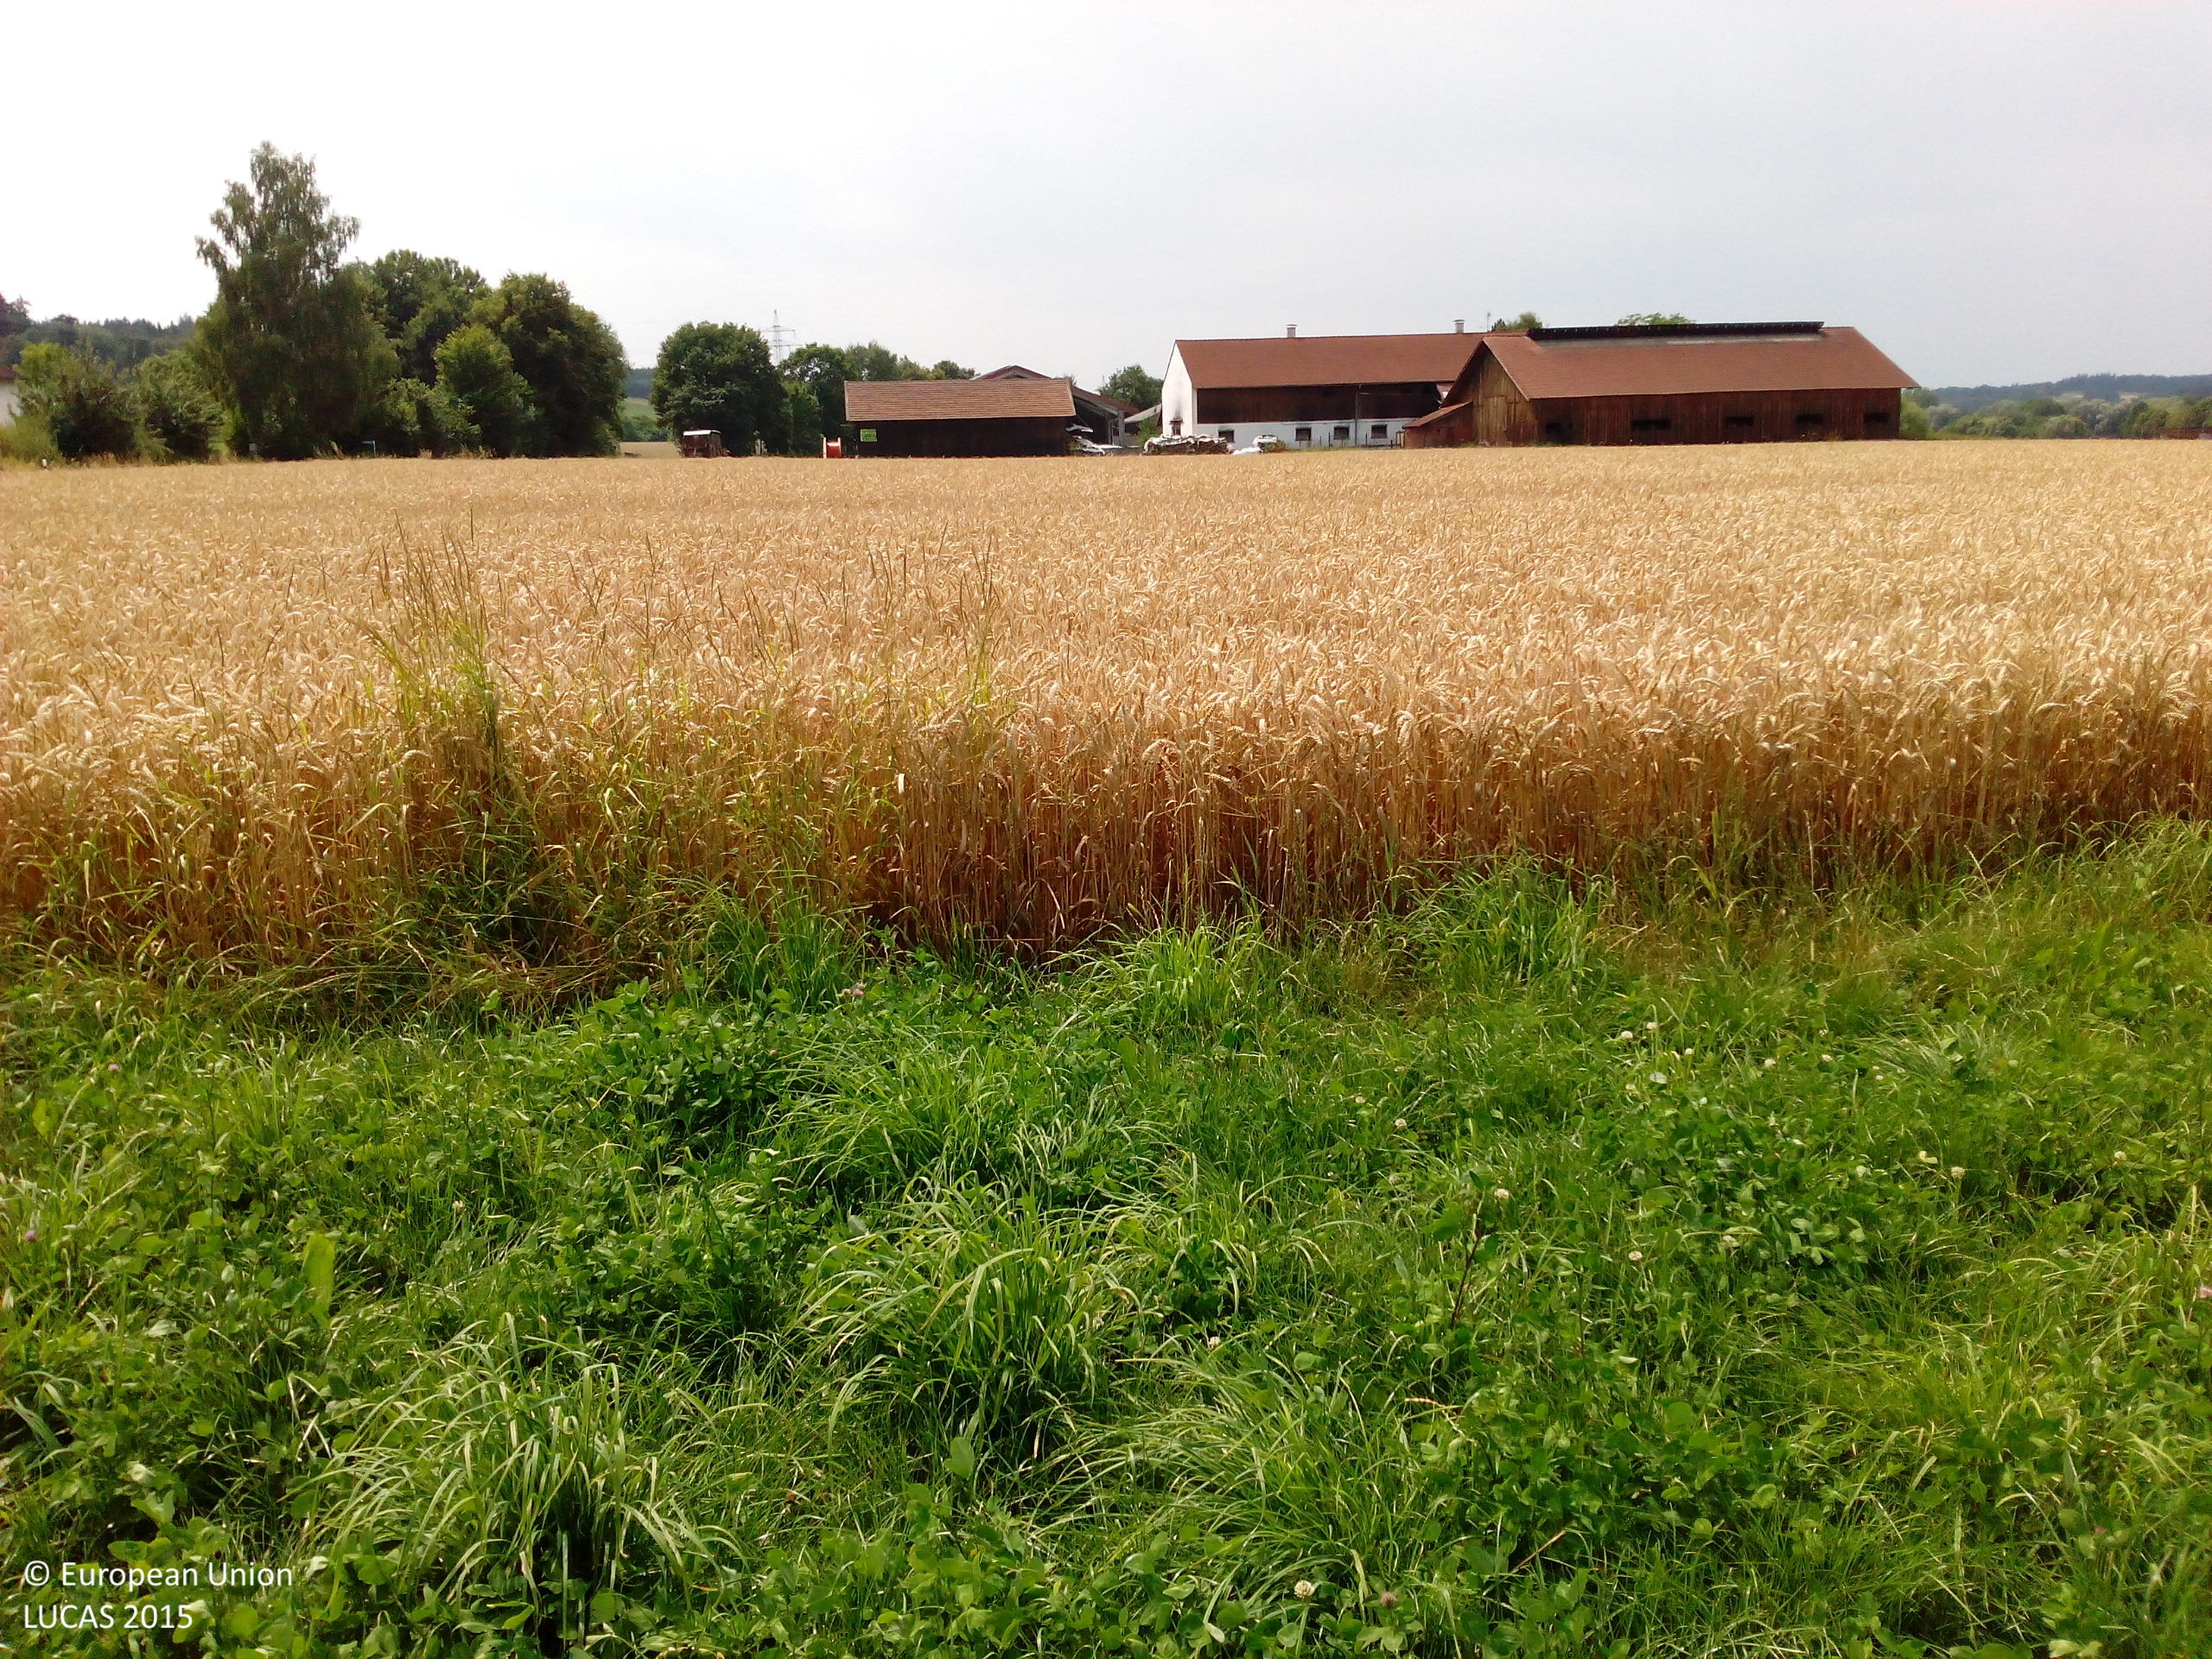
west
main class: Cropland
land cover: Clovers
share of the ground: > 75 %
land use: Agriculture (excluding fallow land and kitchen gardens)
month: July
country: DE
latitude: 48.4187
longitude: 12.9313
